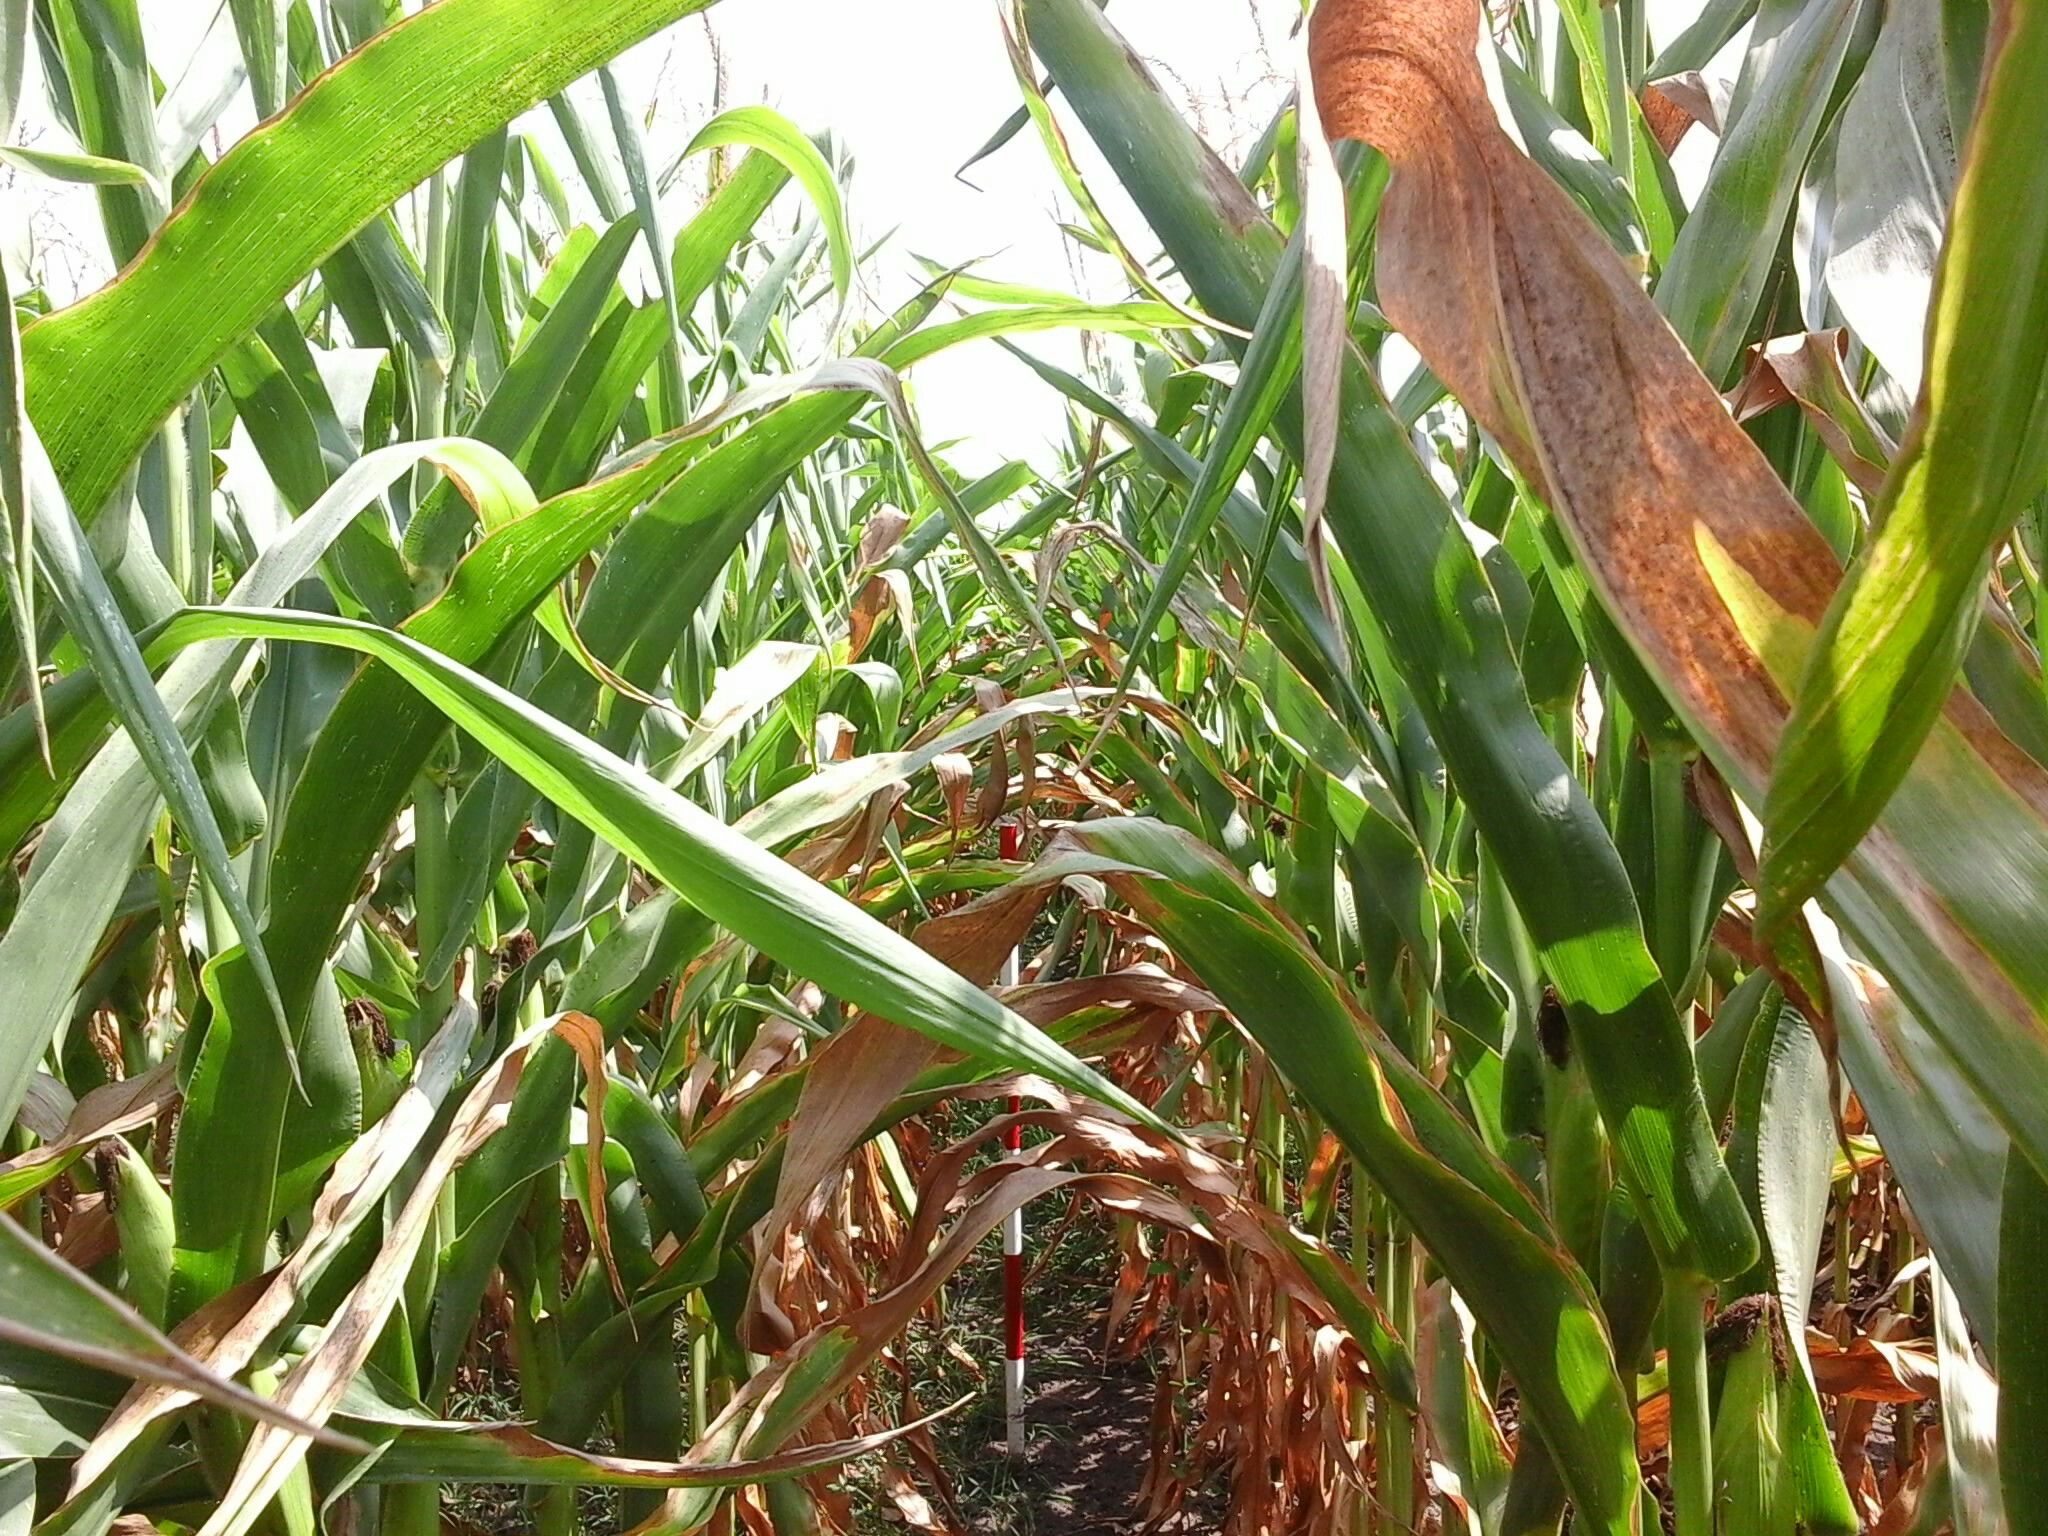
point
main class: Cropland
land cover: Maize
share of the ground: > 75 %
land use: Agriculture (excluding fallow land and kitchen gardens)
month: August
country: HU
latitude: 47.5689
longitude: 18.0265
